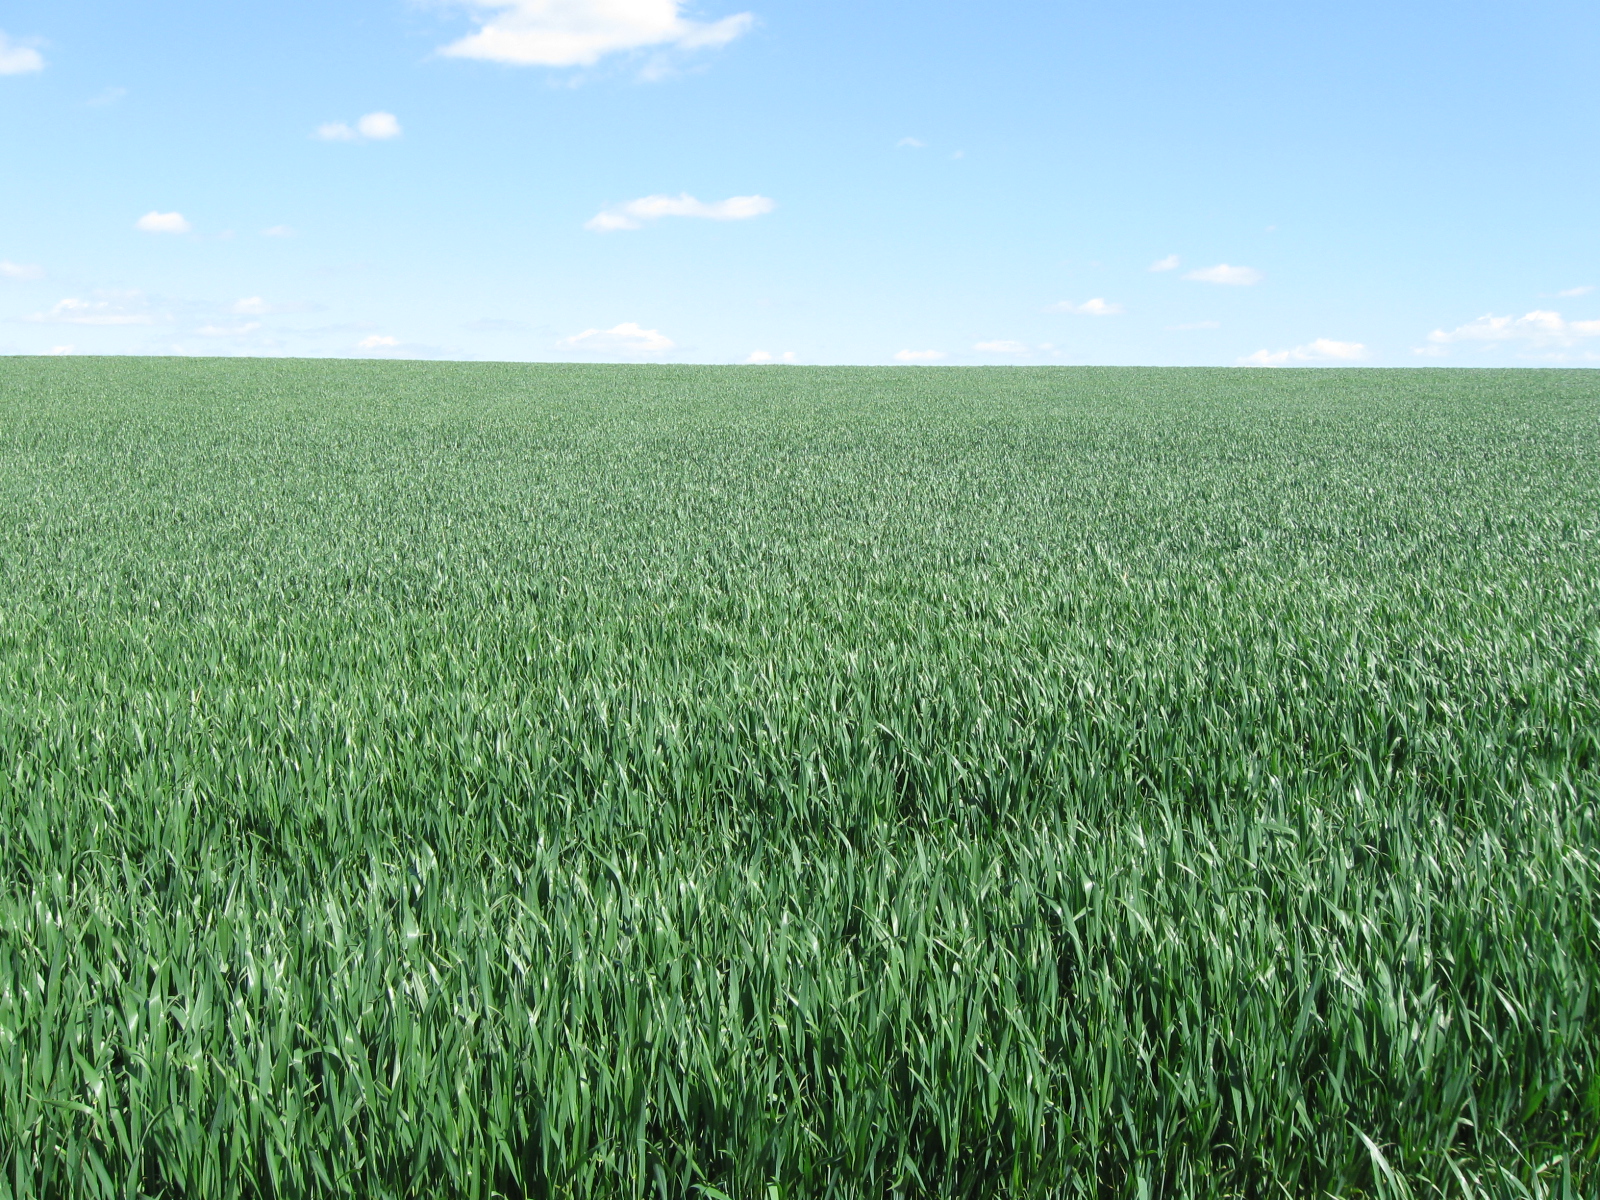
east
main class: Cropland
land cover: Common wheat
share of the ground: > 75 %
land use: Agriculture (excluding fallow land and kitchen gardens)
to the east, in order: Common wheat
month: June
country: LT
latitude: 54.4123
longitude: 23.8174
